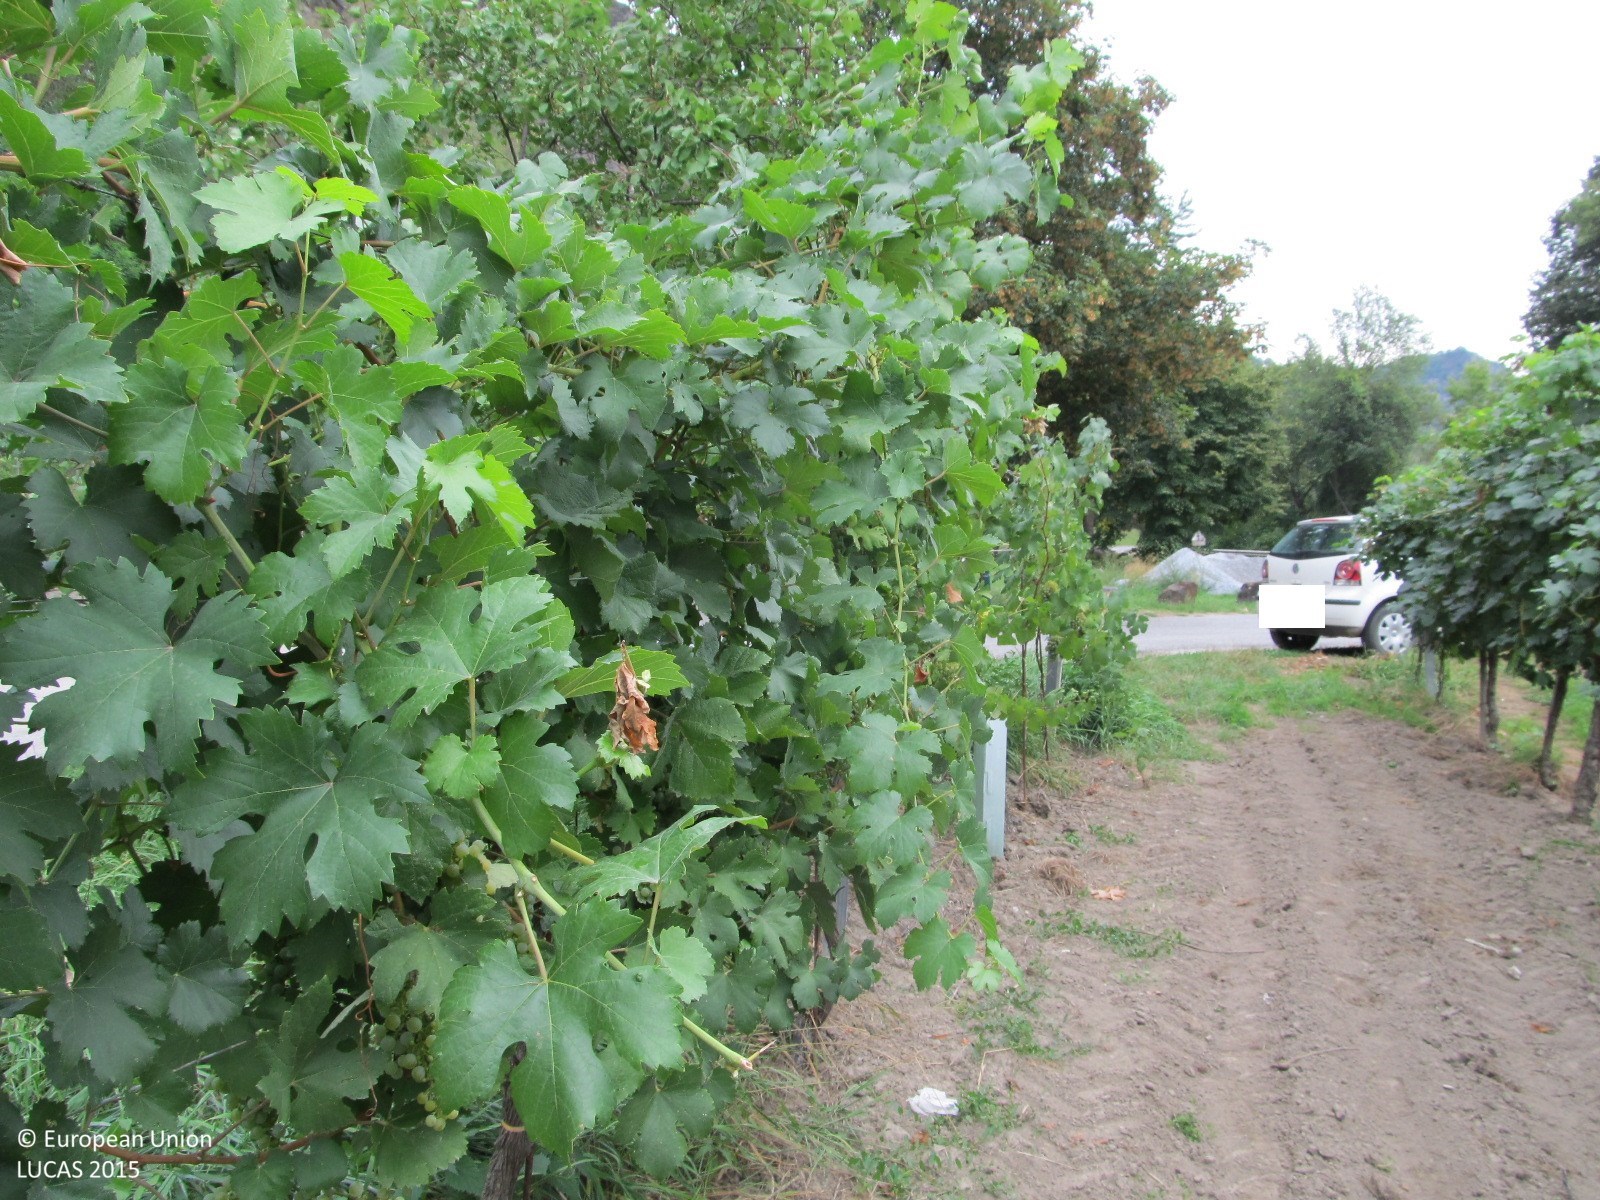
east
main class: Cropland
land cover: Vineyards
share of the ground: 10 - 25 %
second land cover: Other bare soil
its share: > 75 %
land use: Agriculture (excluding fallow land and kitchen gardens)
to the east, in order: Vineyards; Other bare soil; Paved roads, cycling and walking lanes; Single bushes/trees; Tracks; Grass margins; Dry stone walls; Vineyards; Dry stone walls; Managed hedges; Electric lines; Railways; Broadleaved woodland; Fences; Broadleaved woodland; Rocks and stones; Broadleaved woodland; Rocks and stones; Broadleaved woodland
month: September
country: AT
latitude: 48.4109
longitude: 15.5012
